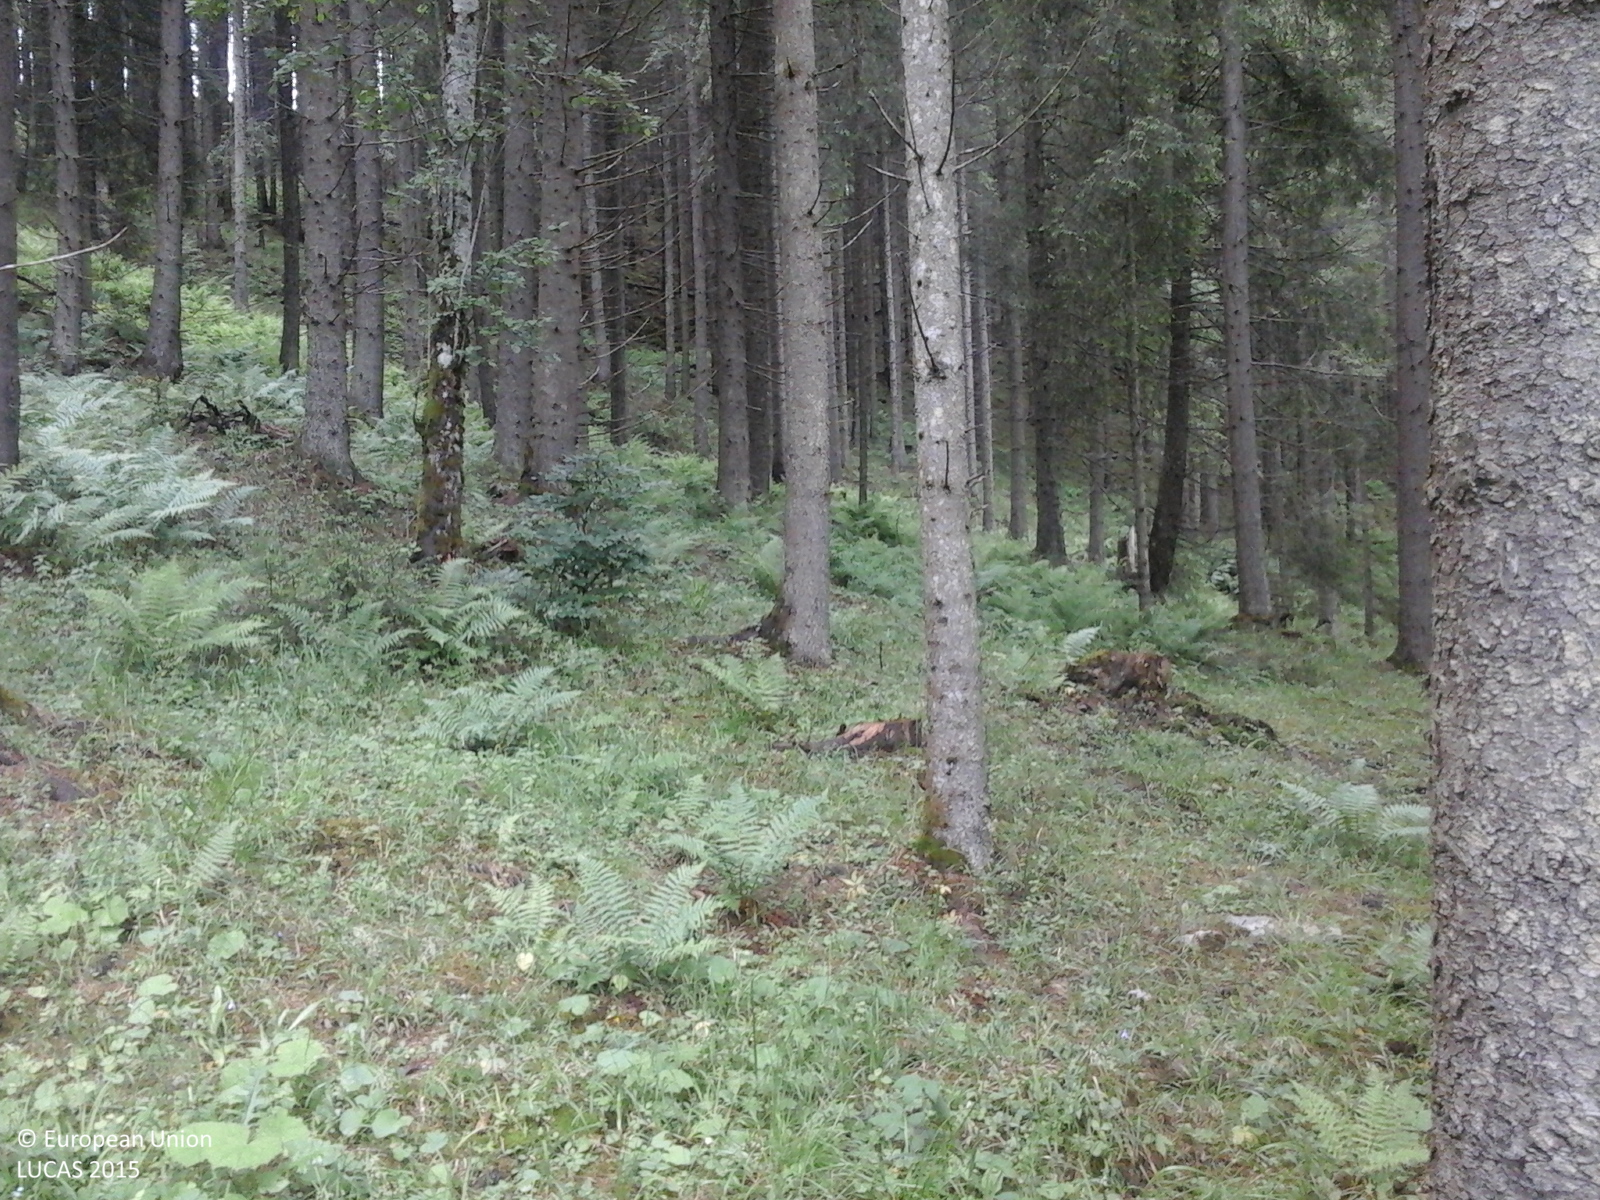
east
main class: Woodland
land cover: Spruce dominated coniferous woodland
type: alpine coniferous forest
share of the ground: > 75 %
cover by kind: coniferous forest trees 85 %, herbaceous plants 10 %, shrubs 5 %
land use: Forestry
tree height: > 5 m
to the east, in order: Spruce dominated coniferous woodland; Tracks; Spruce dominated coniferous woodland
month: June
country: RO
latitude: 47.4208
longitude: 25.1792
